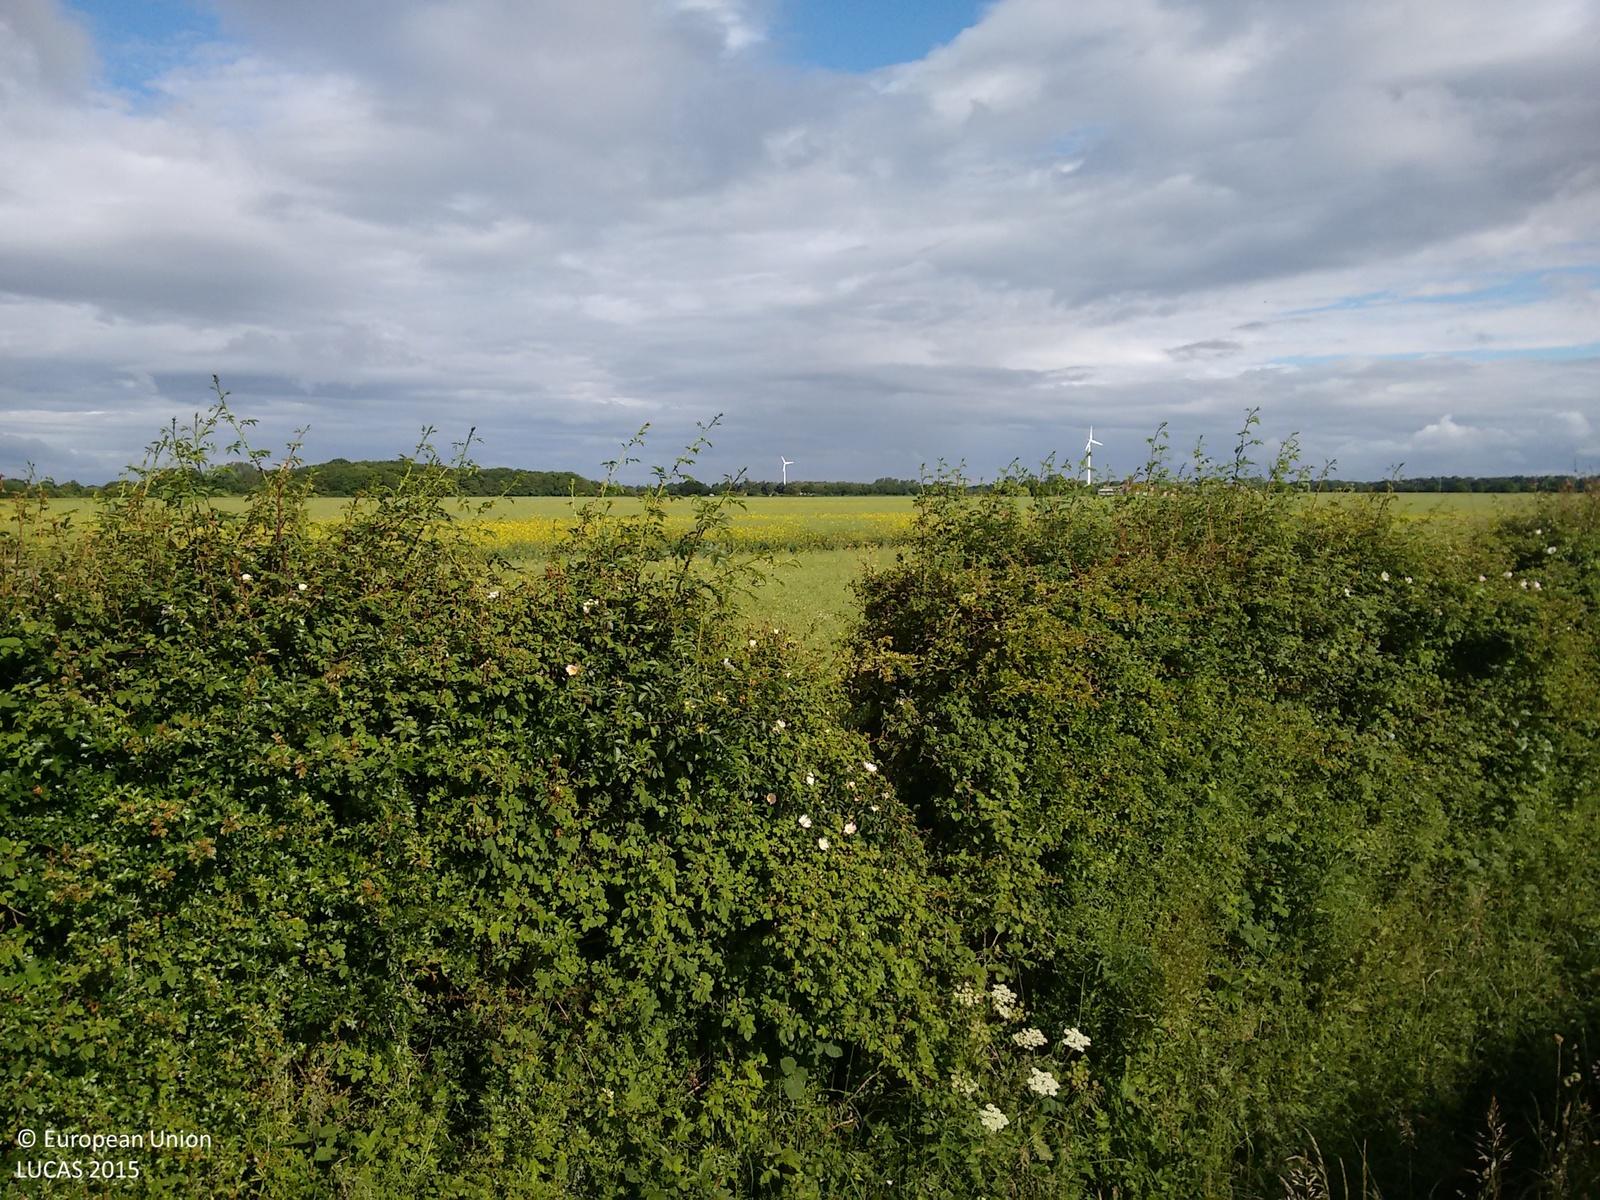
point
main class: Cropland
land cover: Rape and turnip rape
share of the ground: > 75 %
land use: Agriculture (excluding fallow land and kitchen gardens)
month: June
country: GB
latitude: 53.8075
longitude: -0.9917
